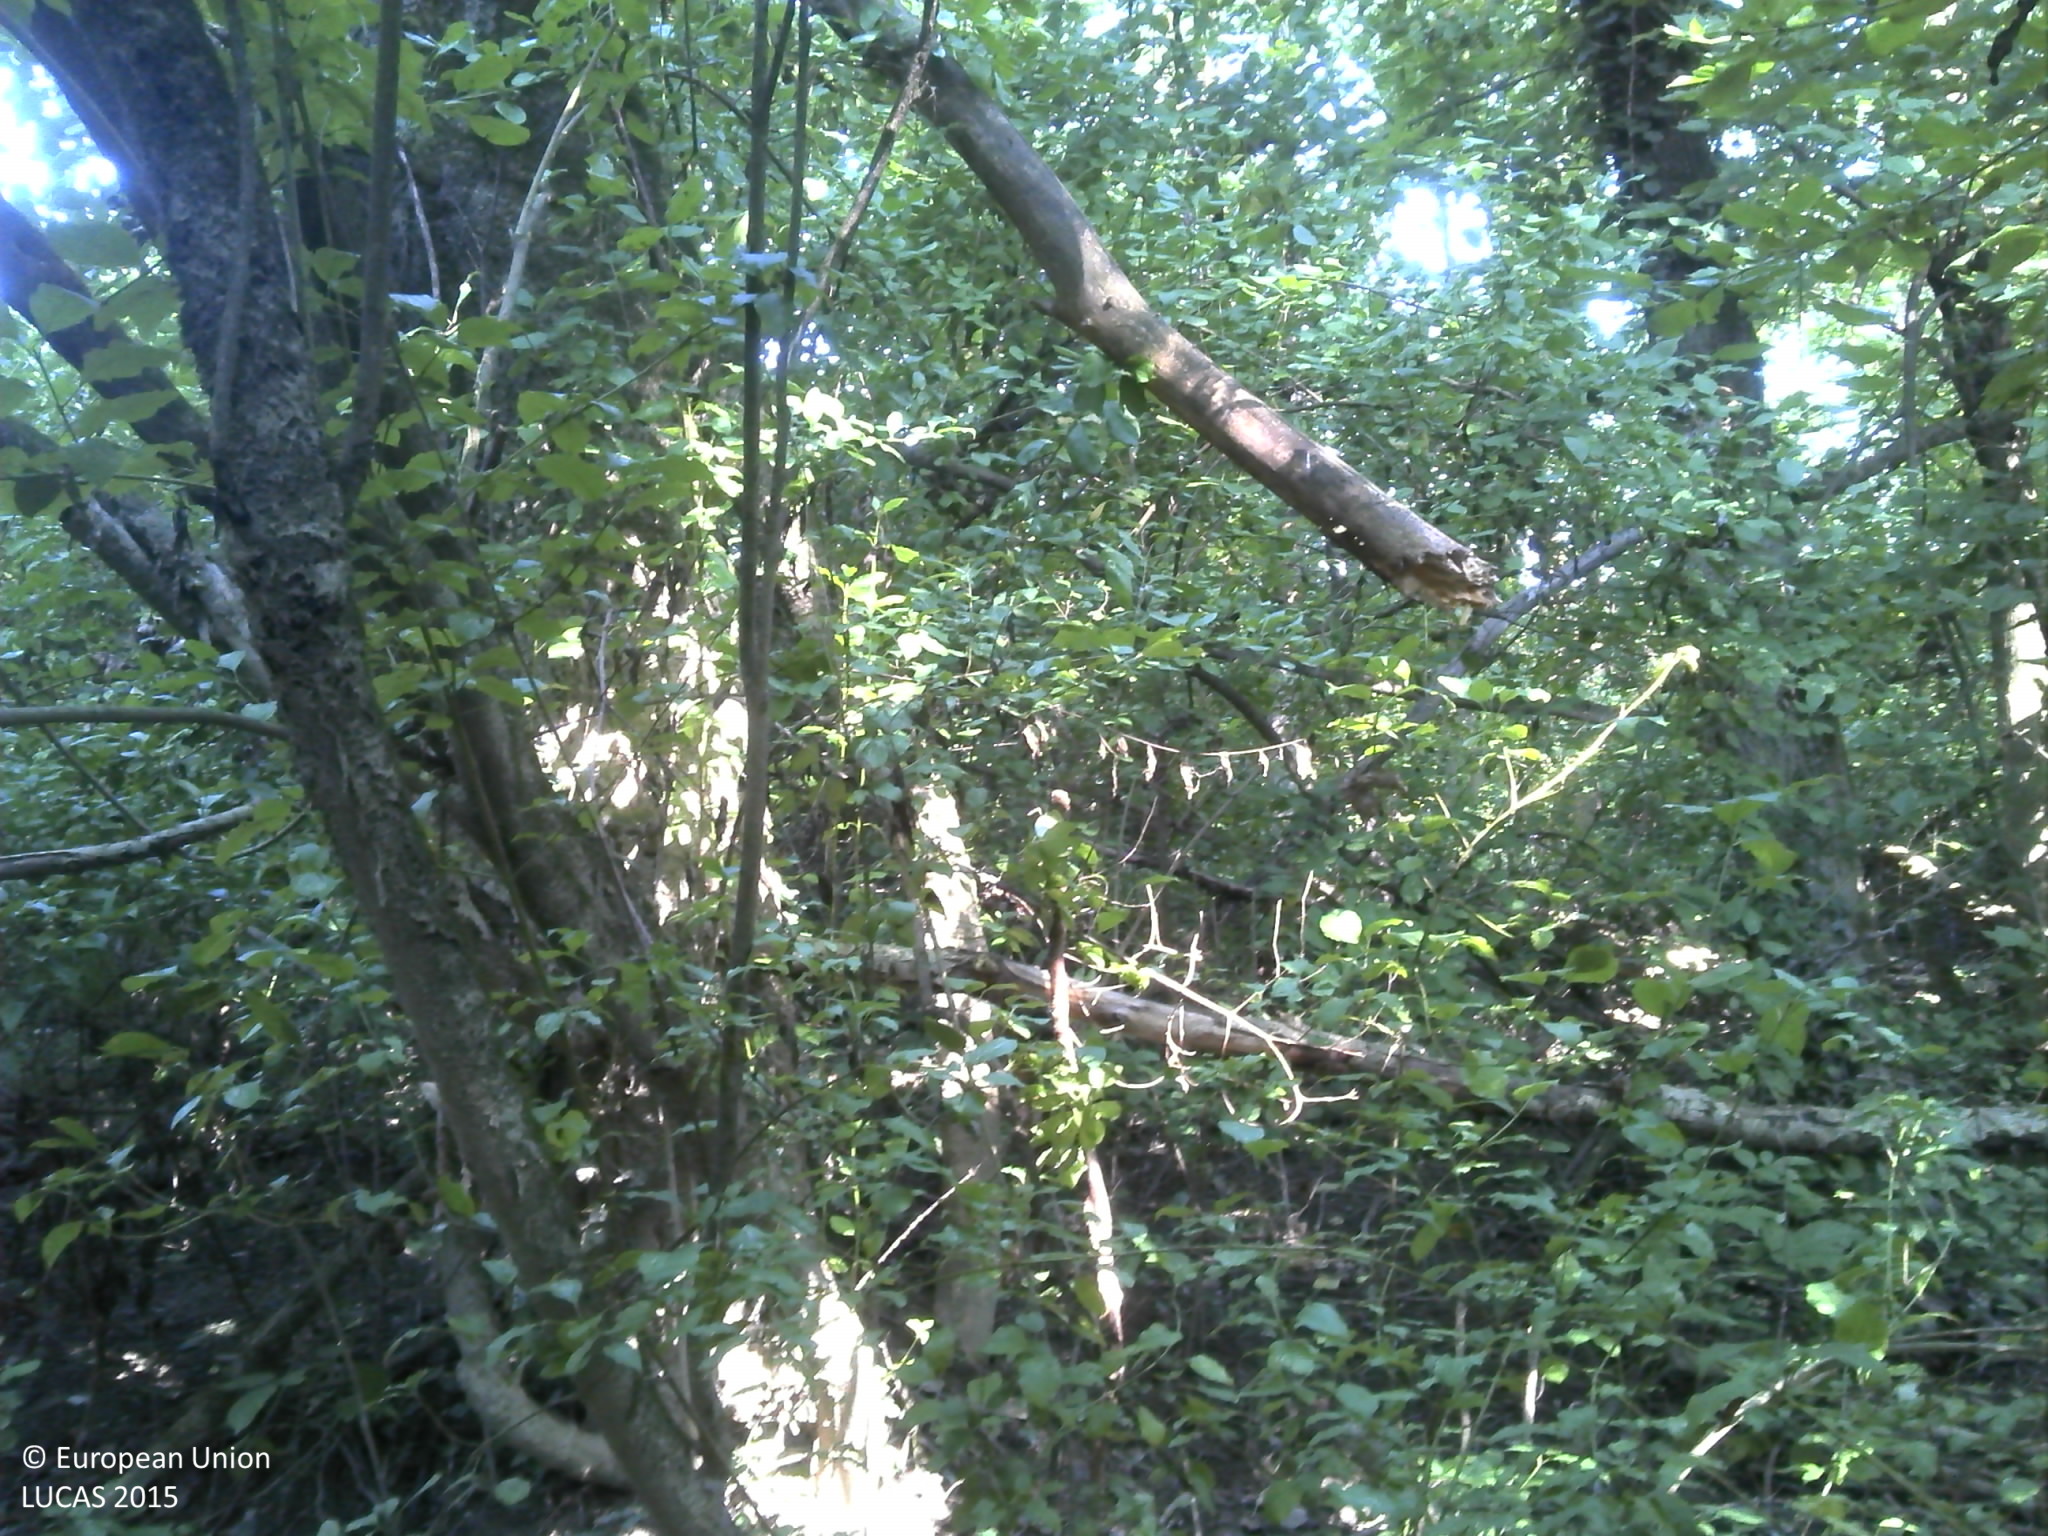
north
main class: Woodland
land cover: Broadleaved woodland
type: mesophytic deciduous forest
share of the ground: > 75 %
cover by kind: broadleaved forest trees 100 %
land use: Forestry
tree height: > 5 m
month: September
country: HR
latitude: 45.6206
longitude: 16.3466
